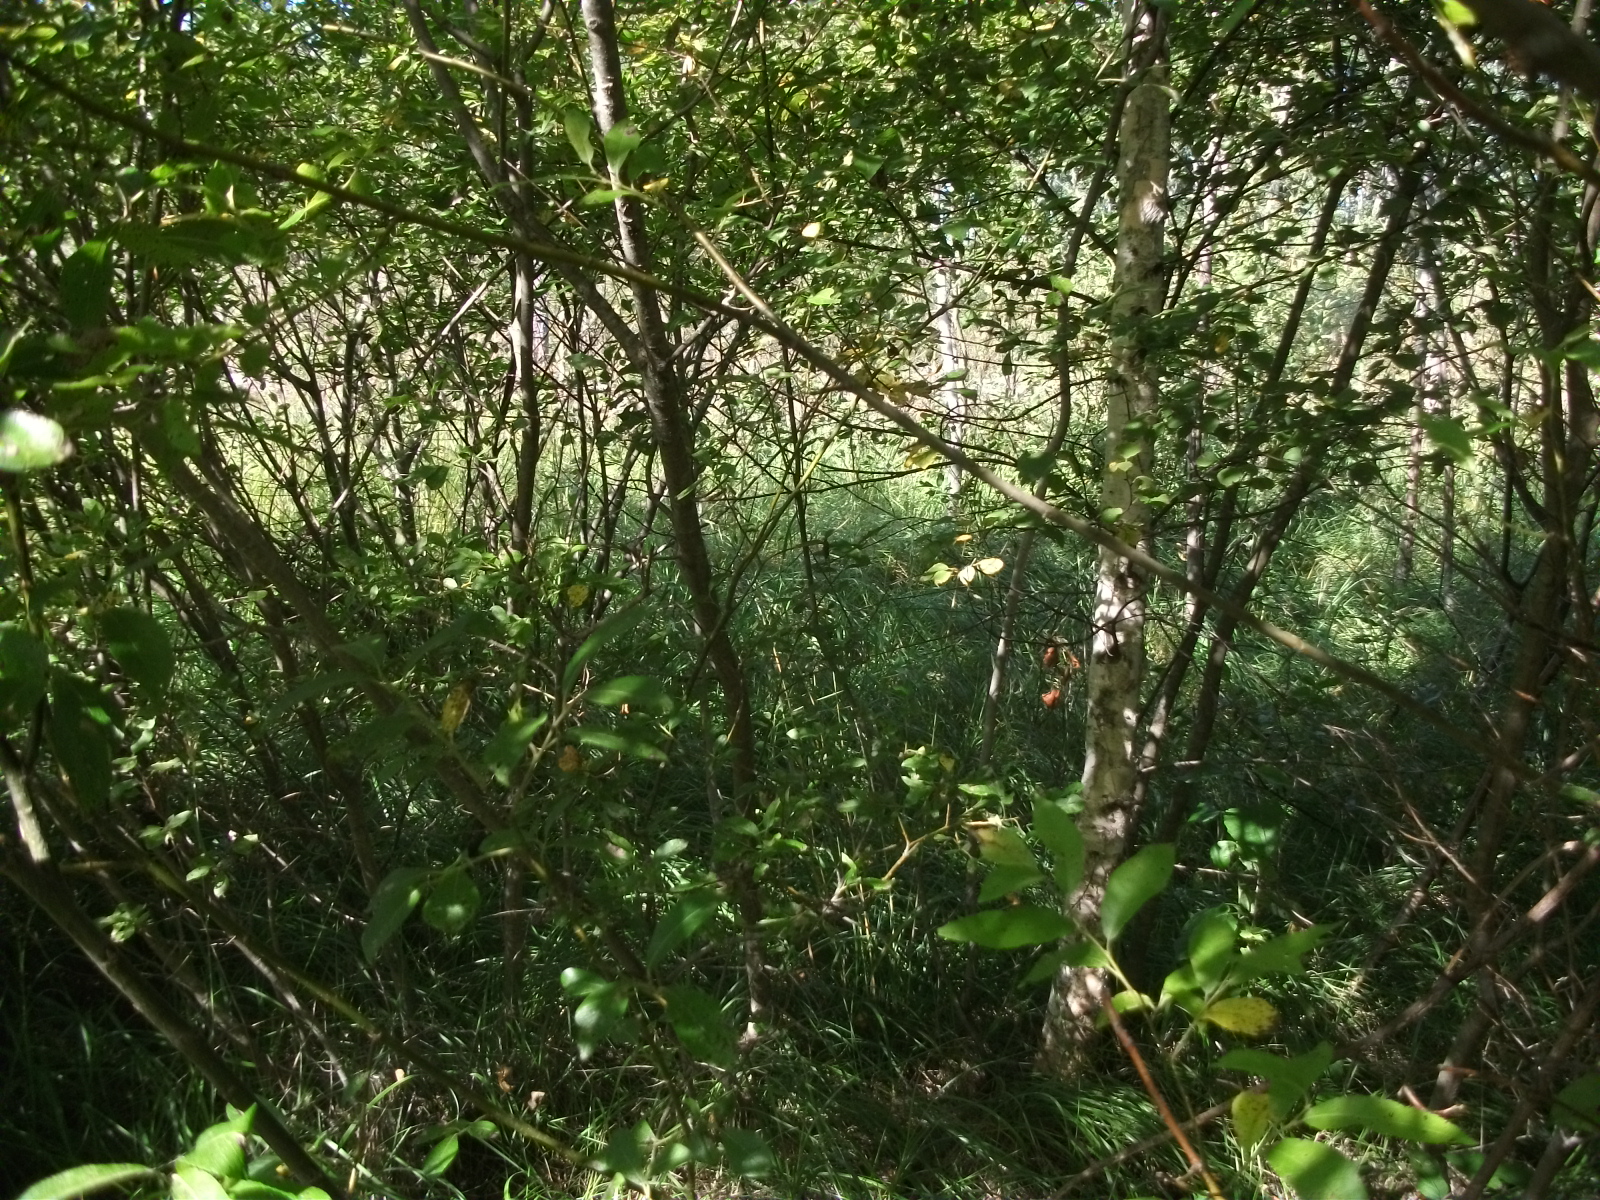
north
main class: Woodland
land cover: Broadleaved woodland
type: non-riverine alder, birch or aspen forest
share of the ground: 50 - 75 %
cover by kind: broadleaved forest trees 50 %, shrubs 45 %, herbaceous plants 5 %
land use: Semi-natural and natural areas not in use
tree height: < 5 m
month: August
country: LV
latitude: 56.5411
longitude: 26.0898
